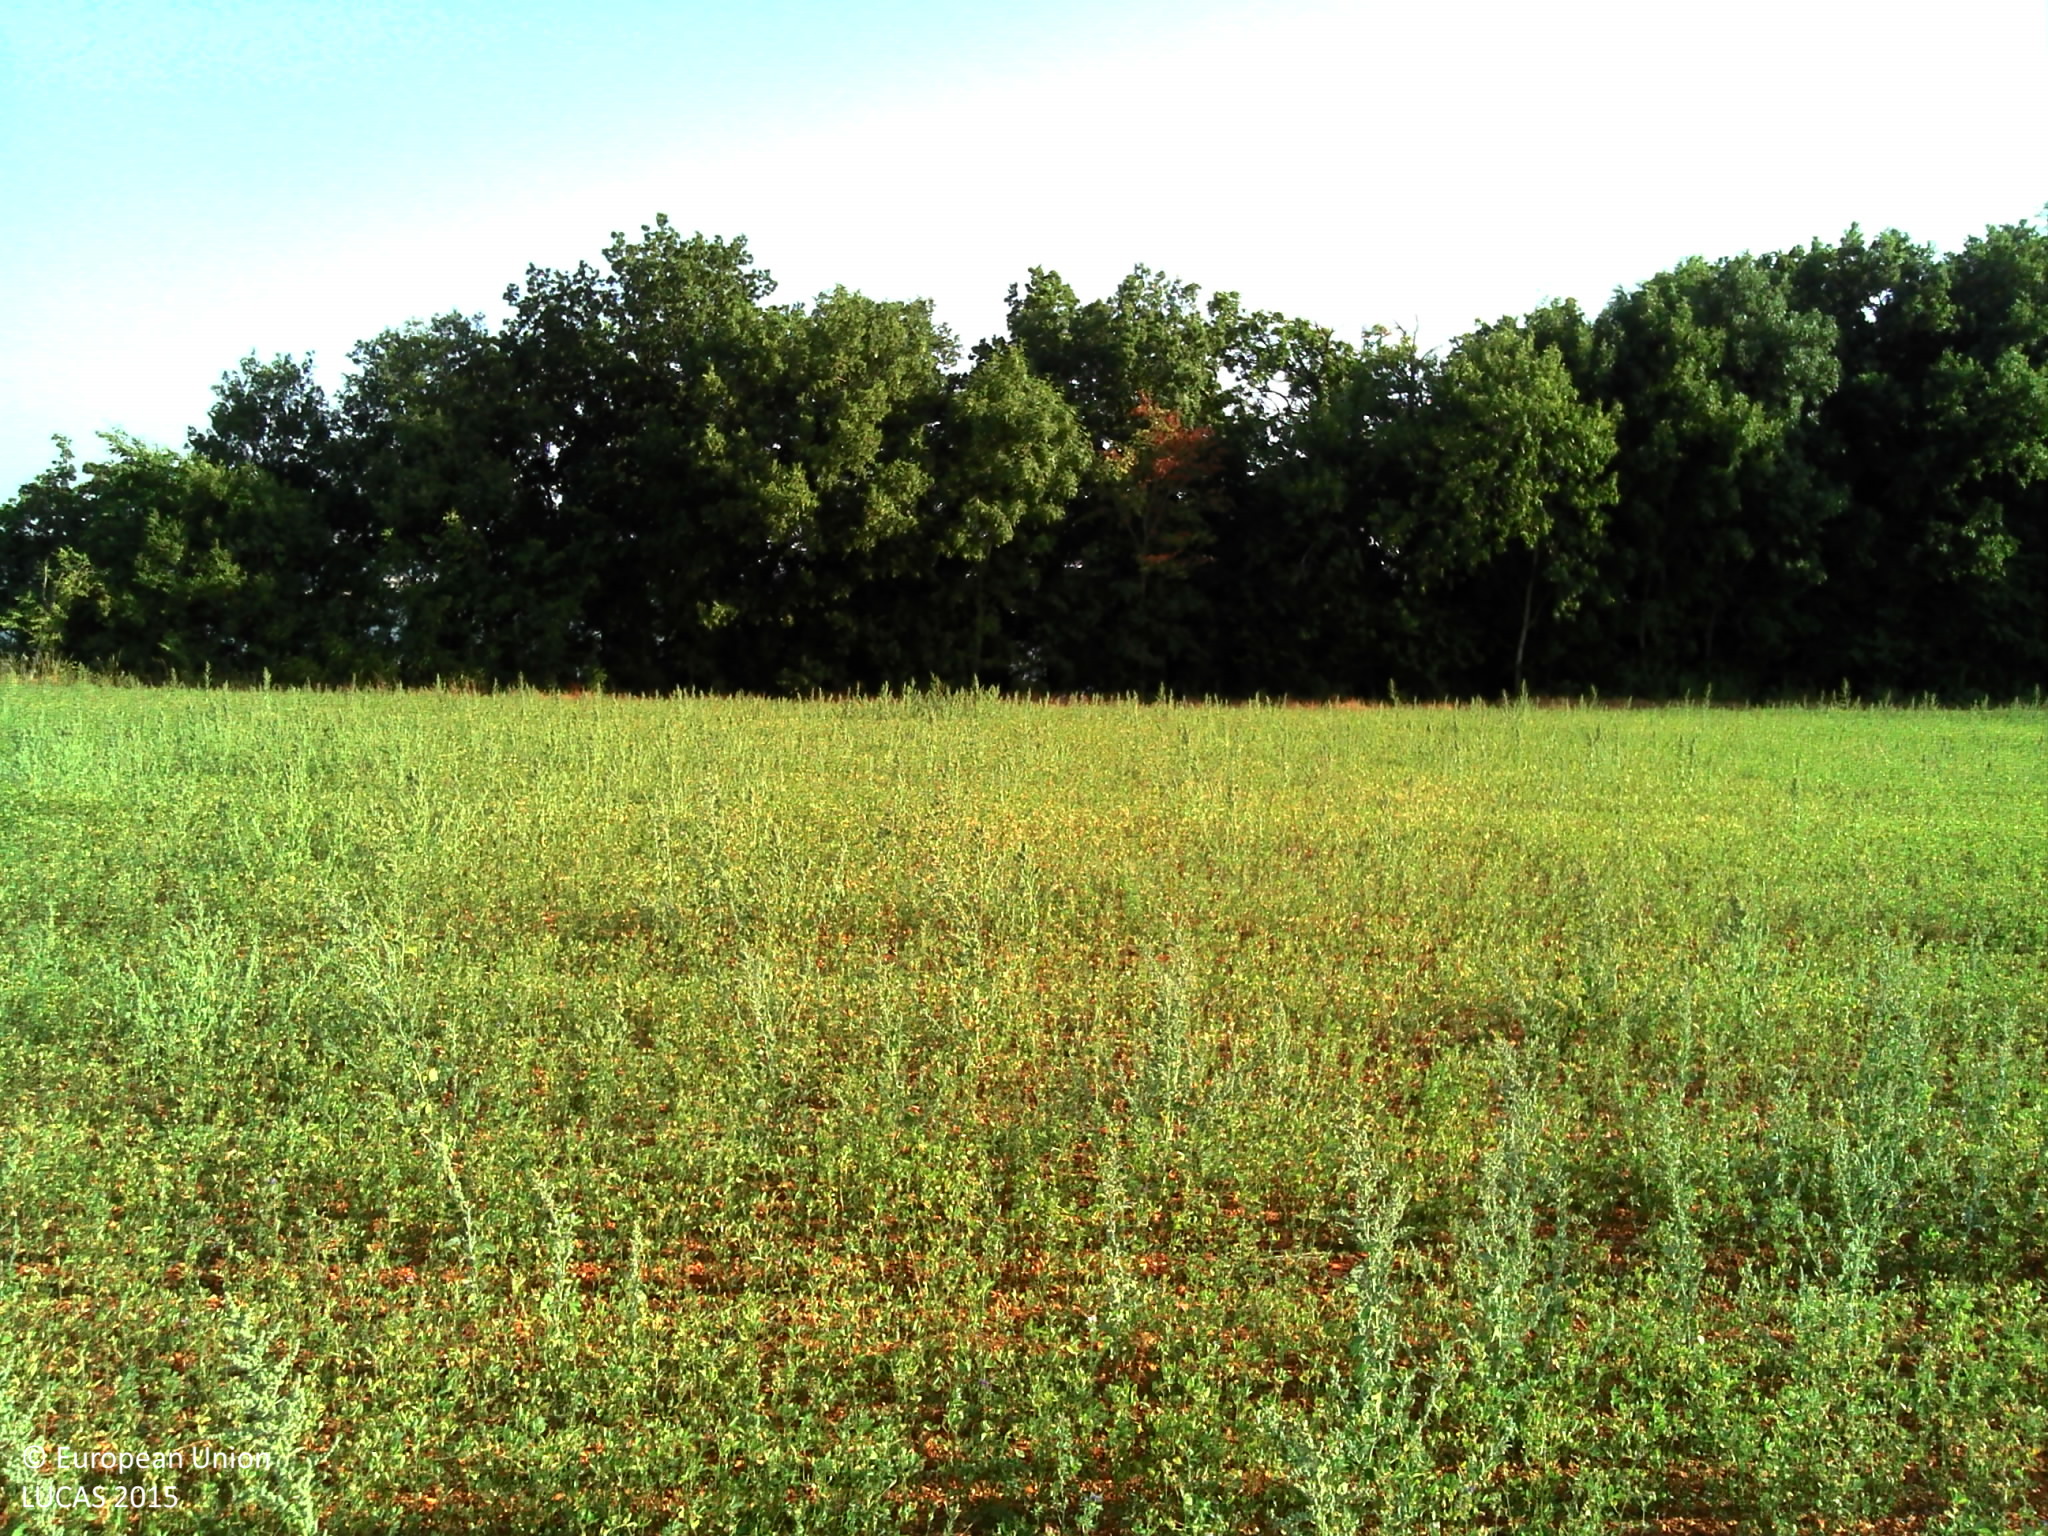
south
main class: Cropland
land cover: Lucerne
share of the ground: 50 - 75 %
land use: Agriculture (excluding fallow land and kitchen gardens)
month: August
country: FR
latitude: 44.0127
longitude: 3.1084
